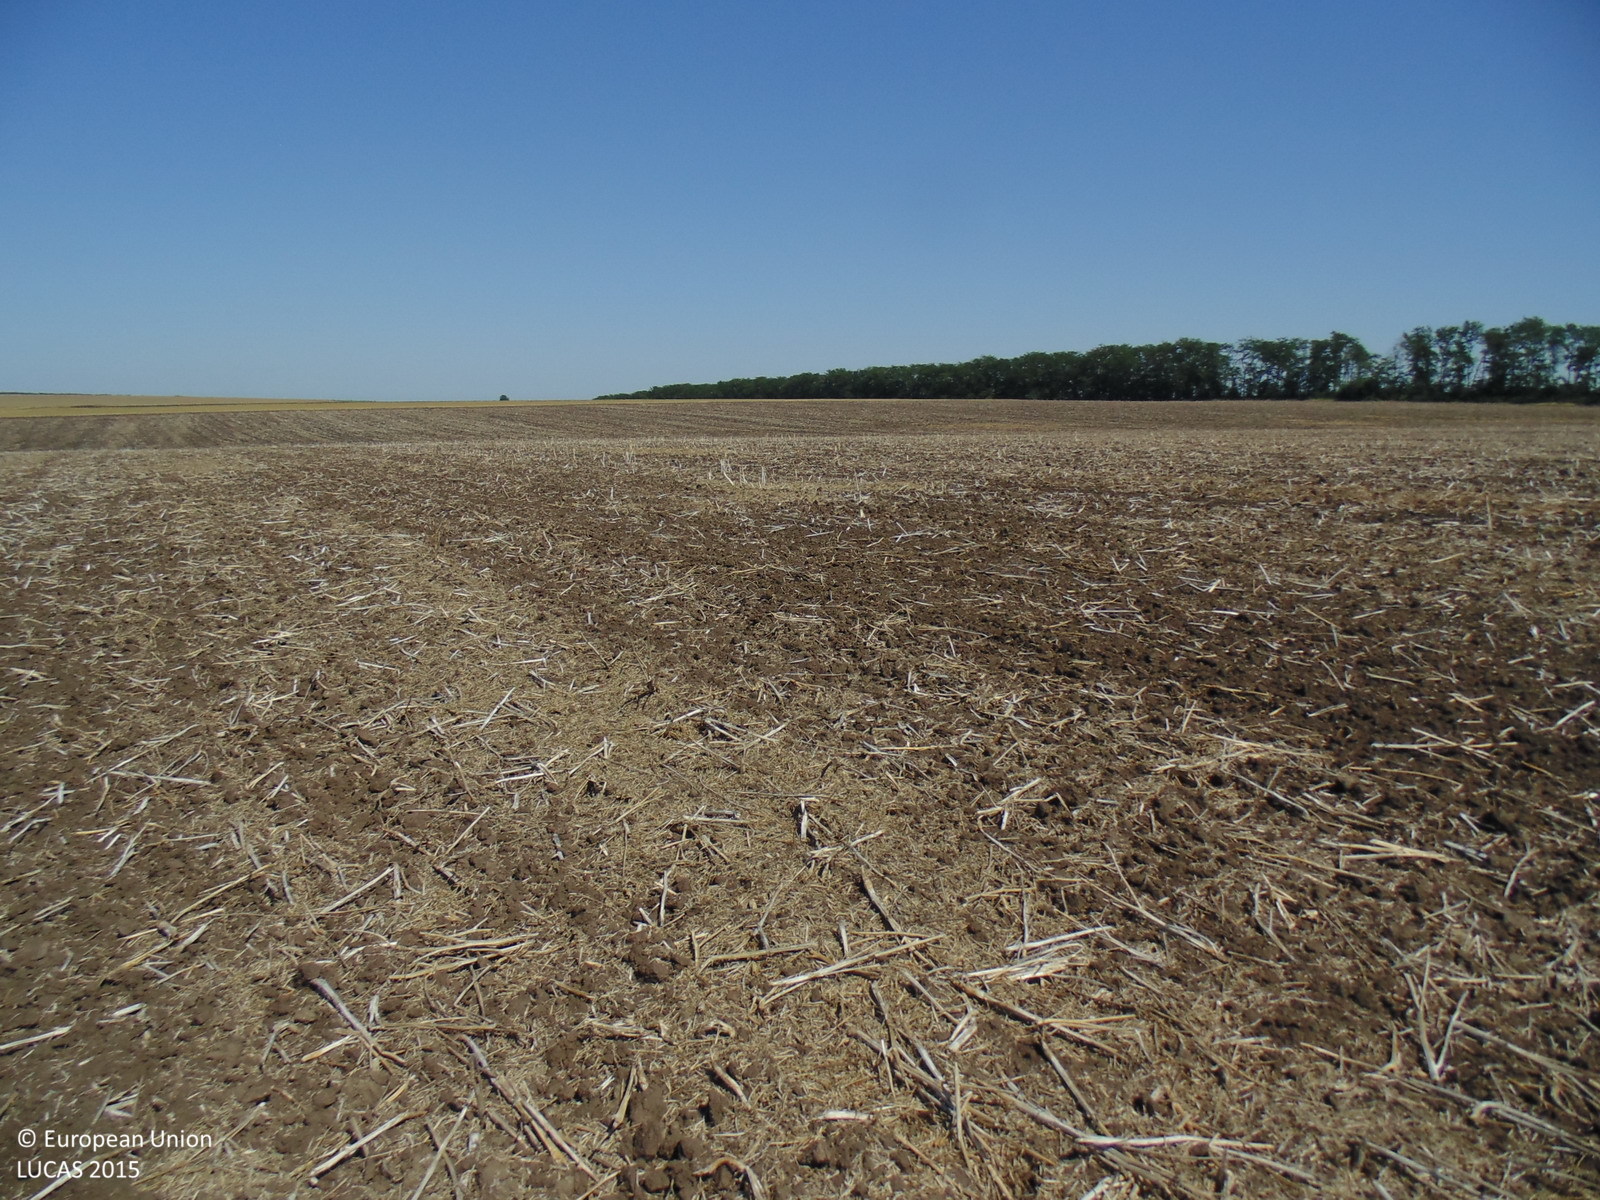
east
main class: Cropland
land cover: Rape and turnip rape
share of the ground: < 10 %
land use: Agriculture (excluding fallow land and kitchen gardens)
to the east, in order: Rape and turnip rape
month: August
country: BG
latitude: 43.5350
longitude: 28.2069
